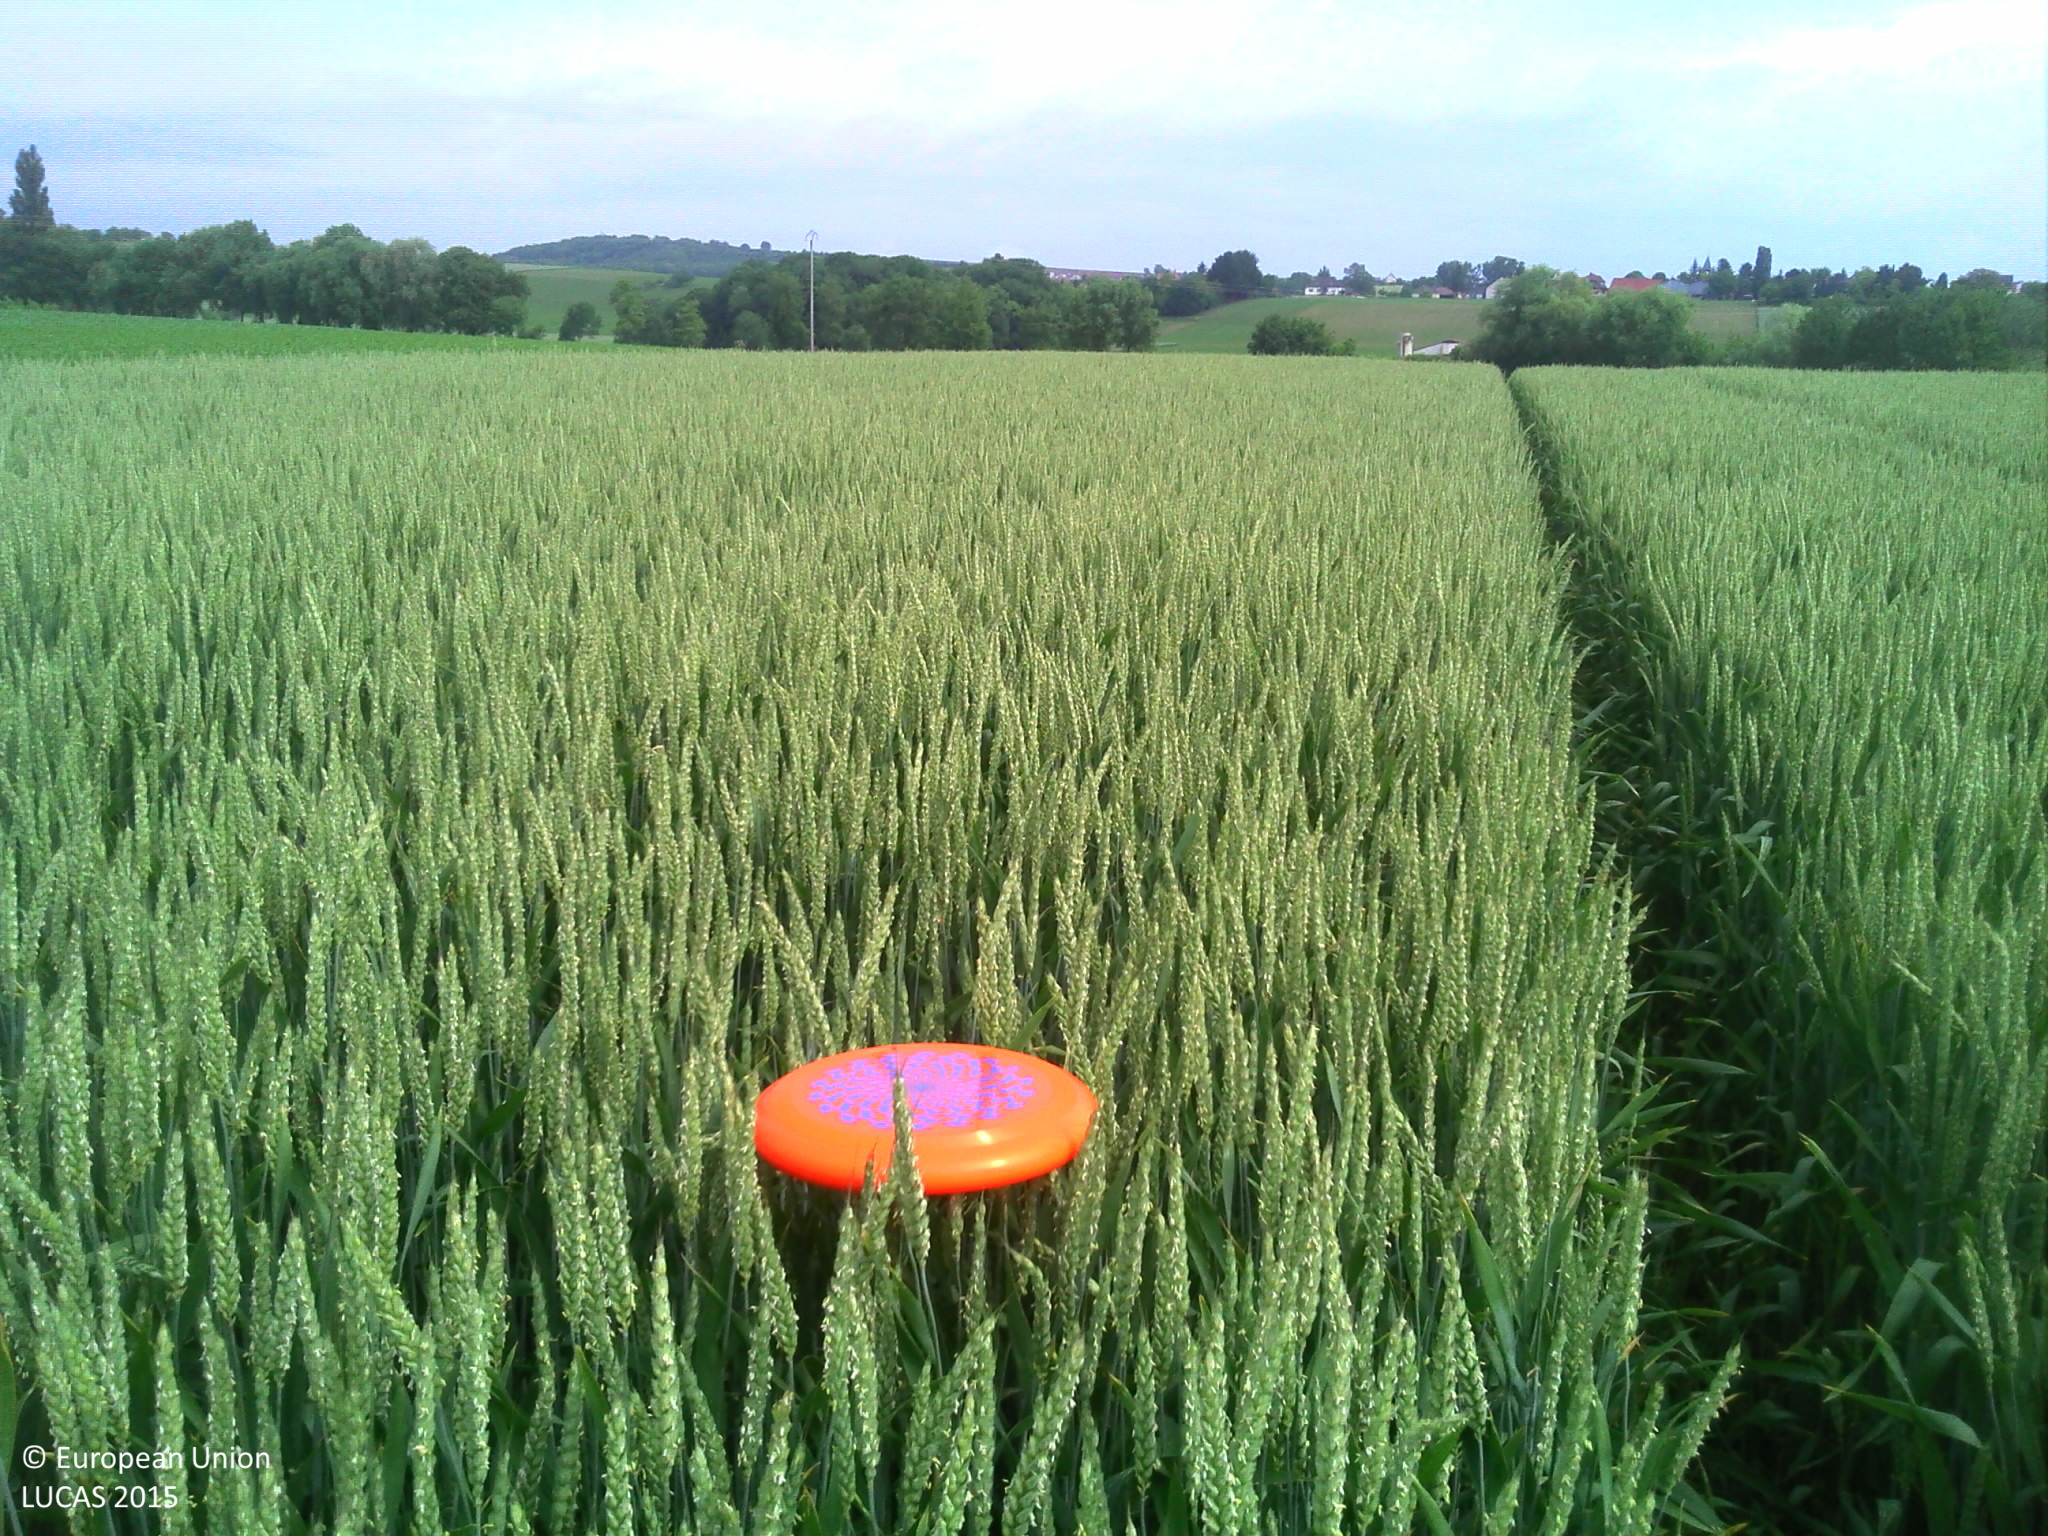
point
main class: Cropland
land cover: Common wheat
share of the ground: > 75 %
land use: Agriculture (excluding fallow land and kitchen gardens)
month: May
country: FR
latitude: 48.6462
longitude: 7.5441
